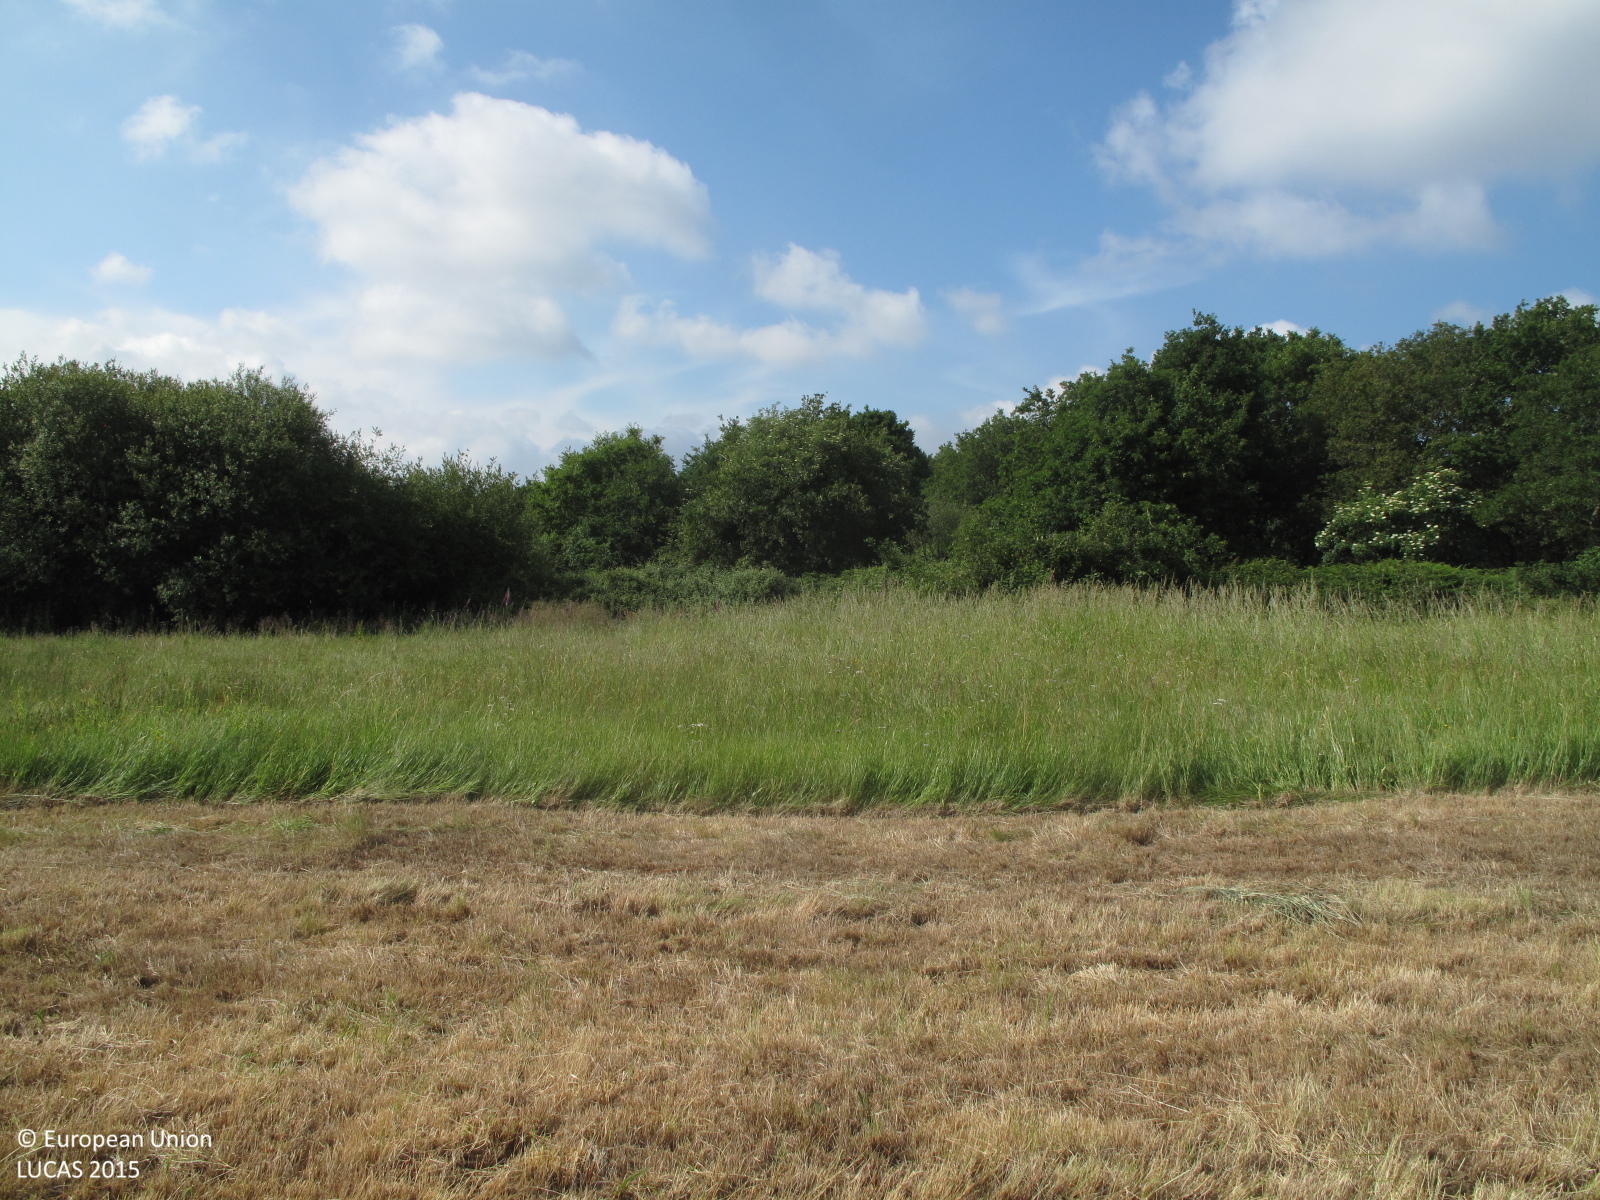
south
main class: Grassland
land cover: Grassland without tree/shrub cover
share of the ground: > 75 %
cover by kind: herbaceous plants 100 %
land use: Agriculture (excluding fallow land and kitchen gardens)
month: June
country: ES
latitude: 42.9374
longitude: -8.4472
